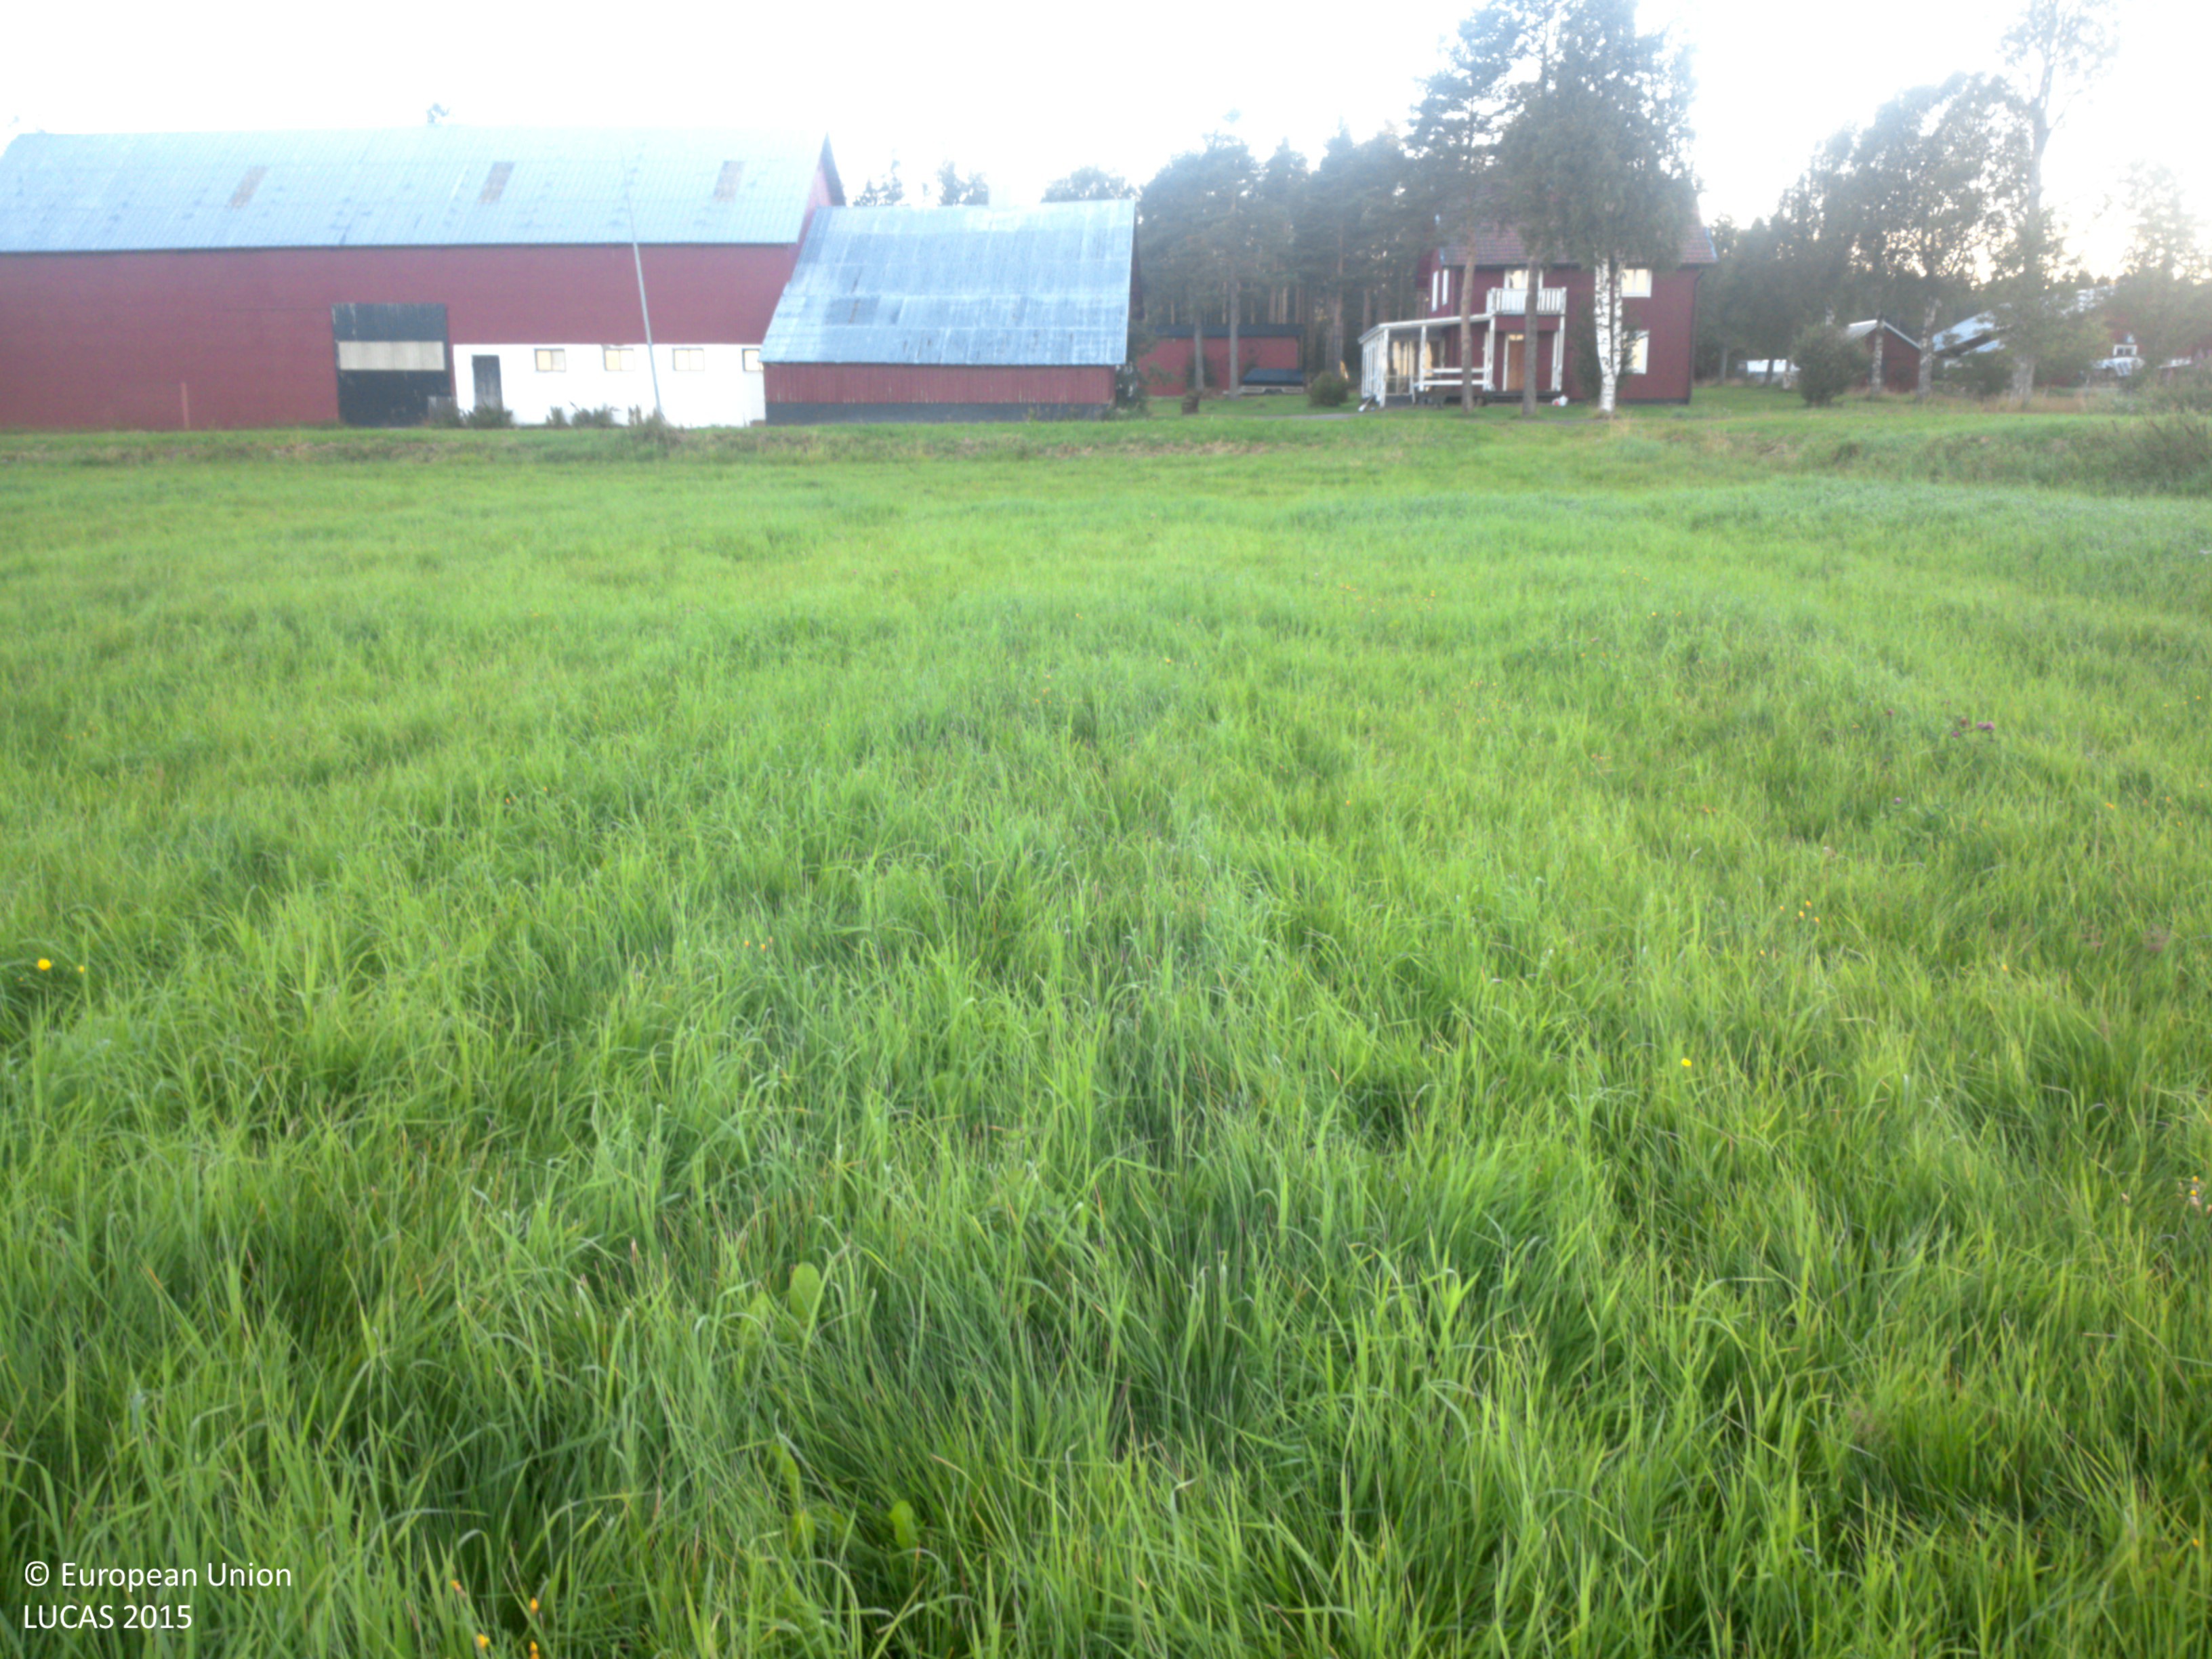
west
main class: Cropland
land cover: Temporary grasslands
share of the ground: > 75 %
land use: Agriculture (excluding fallow land and kitchen gardens)
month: August
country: SE
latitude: 63.7683
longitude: 20.0592
